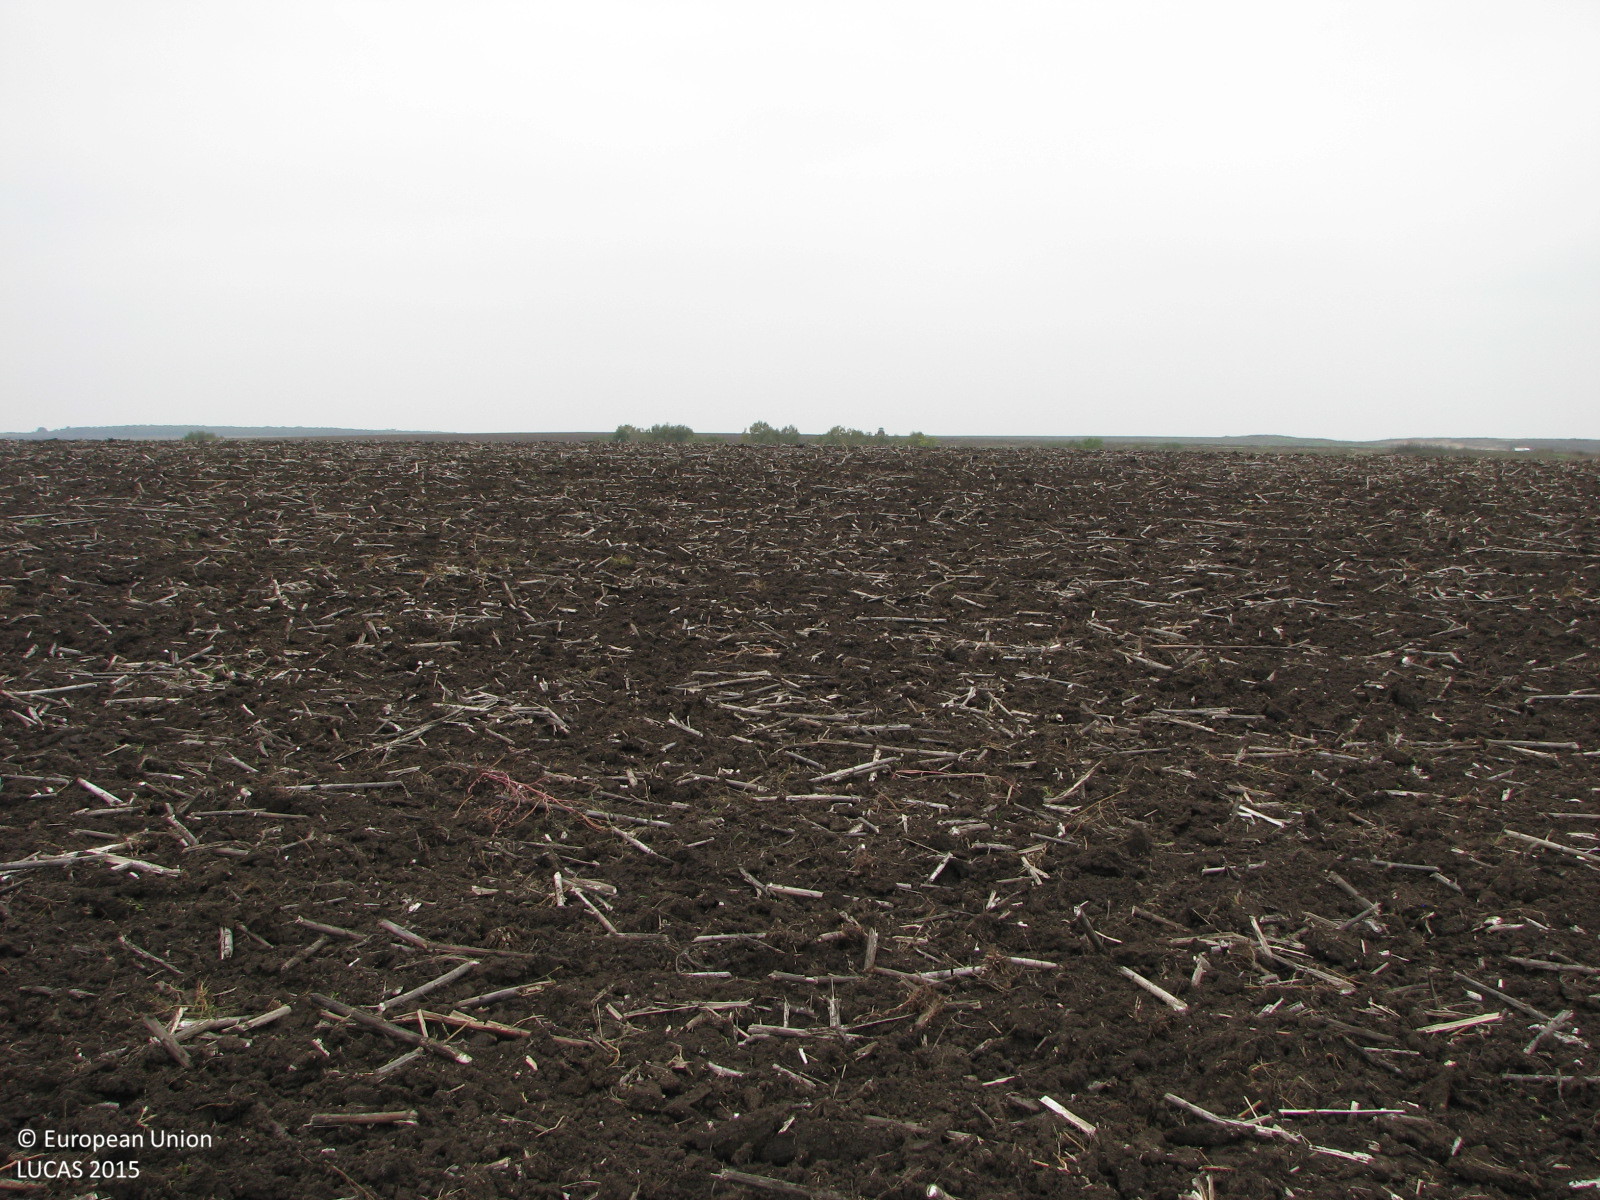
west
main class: Cropland
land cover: Rape and turnip rape
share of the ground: < 10 %
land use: Agriculture (excluding fallow land and kitchen gardens)
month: October
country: BG
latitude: 42.5465
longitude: 26.7955
